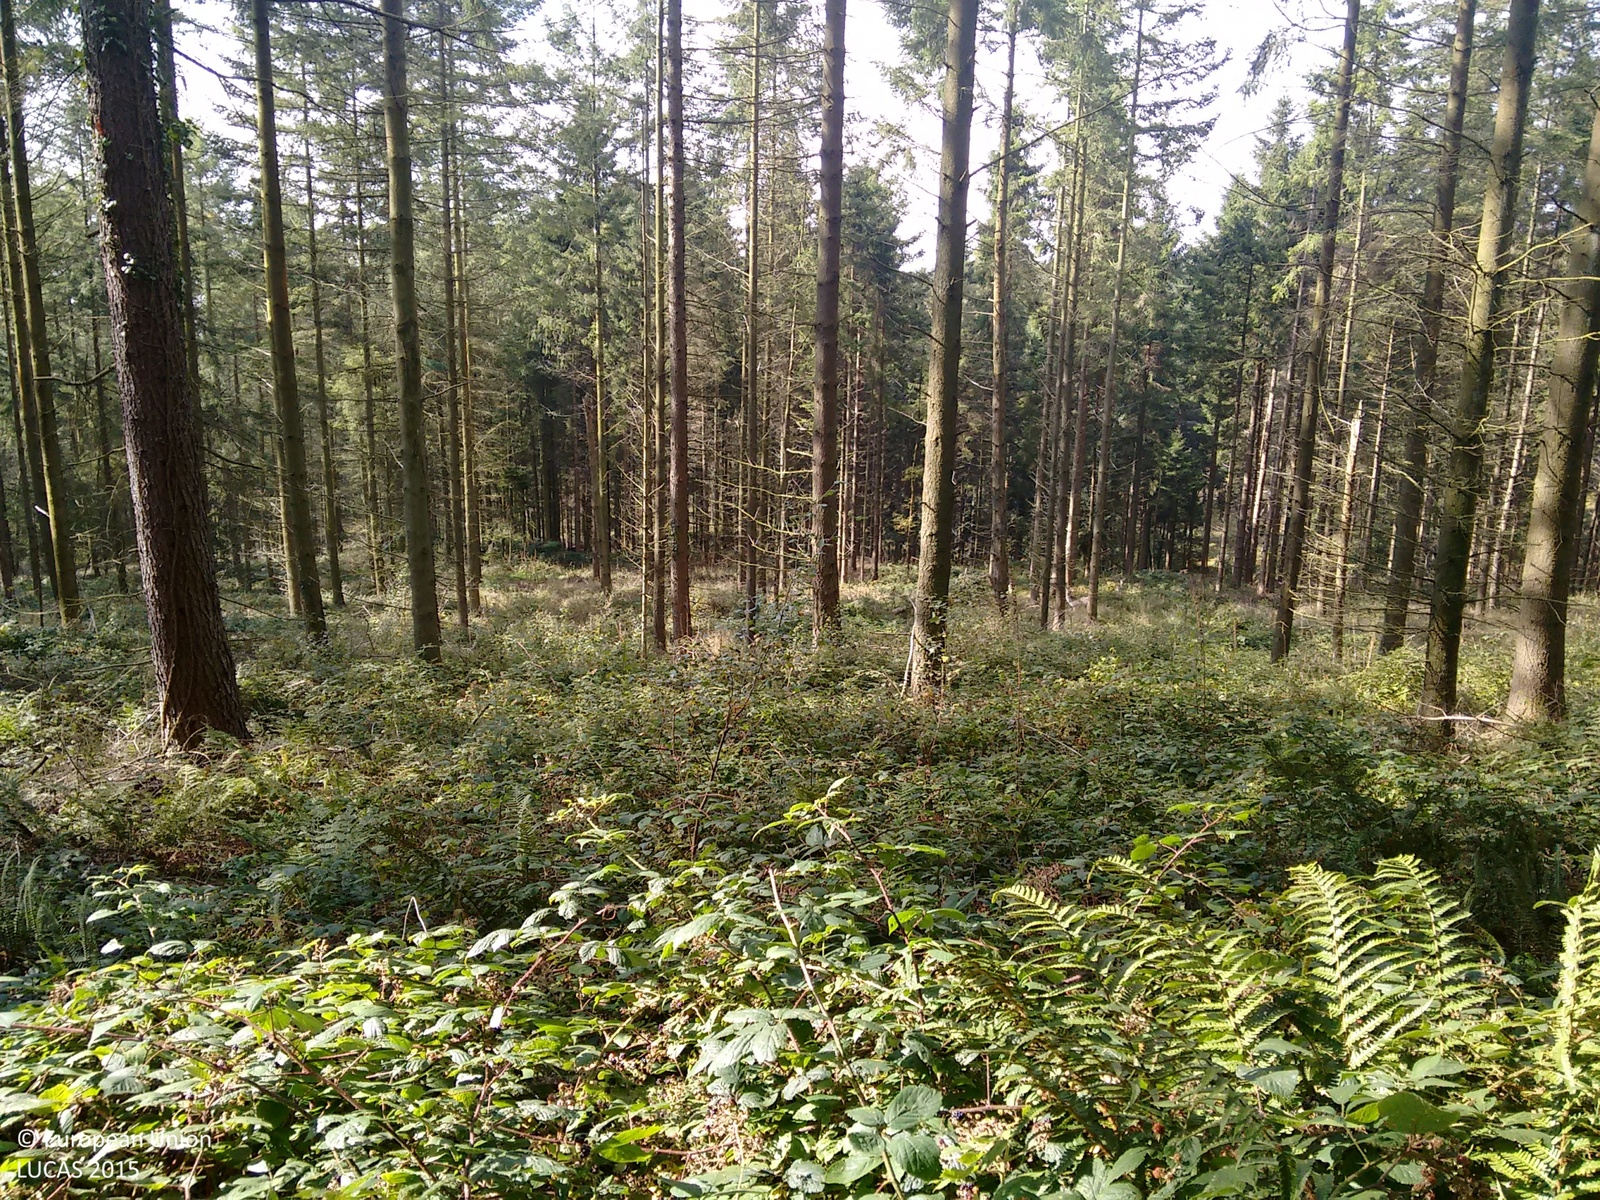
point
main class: Woodland
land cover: Spruce dominated coniferous woodland
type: exotic forest
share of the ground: > 75 %
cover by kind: coniferous forest trees 65 %, shrubs 35 %
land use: Forestry
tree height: > 5 m
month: October
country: GB
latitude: 51.6378
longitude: -2.8602
